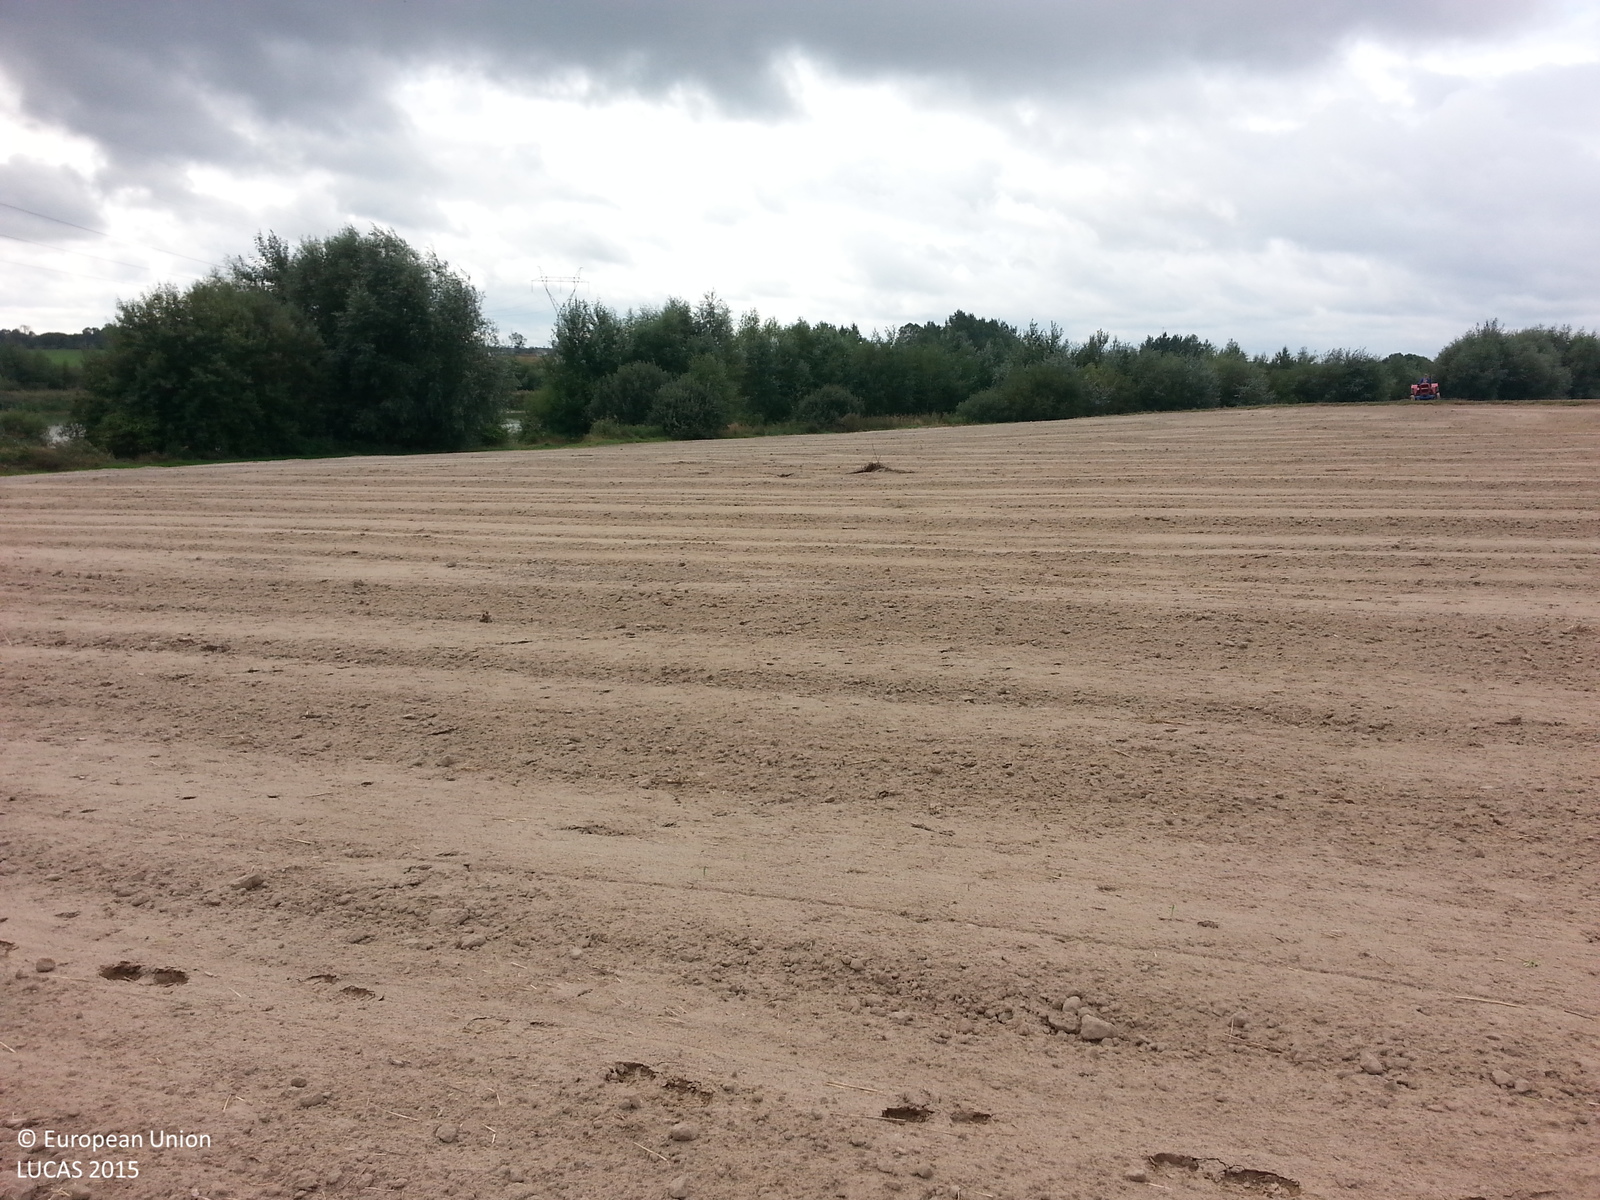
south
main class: Cropland
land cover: Common wheat
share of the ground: < 10 %
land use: Agriculture (excluding fallow land and kitchen gardens)
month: September
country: PL
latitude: 53.2531
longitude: 18.1548
